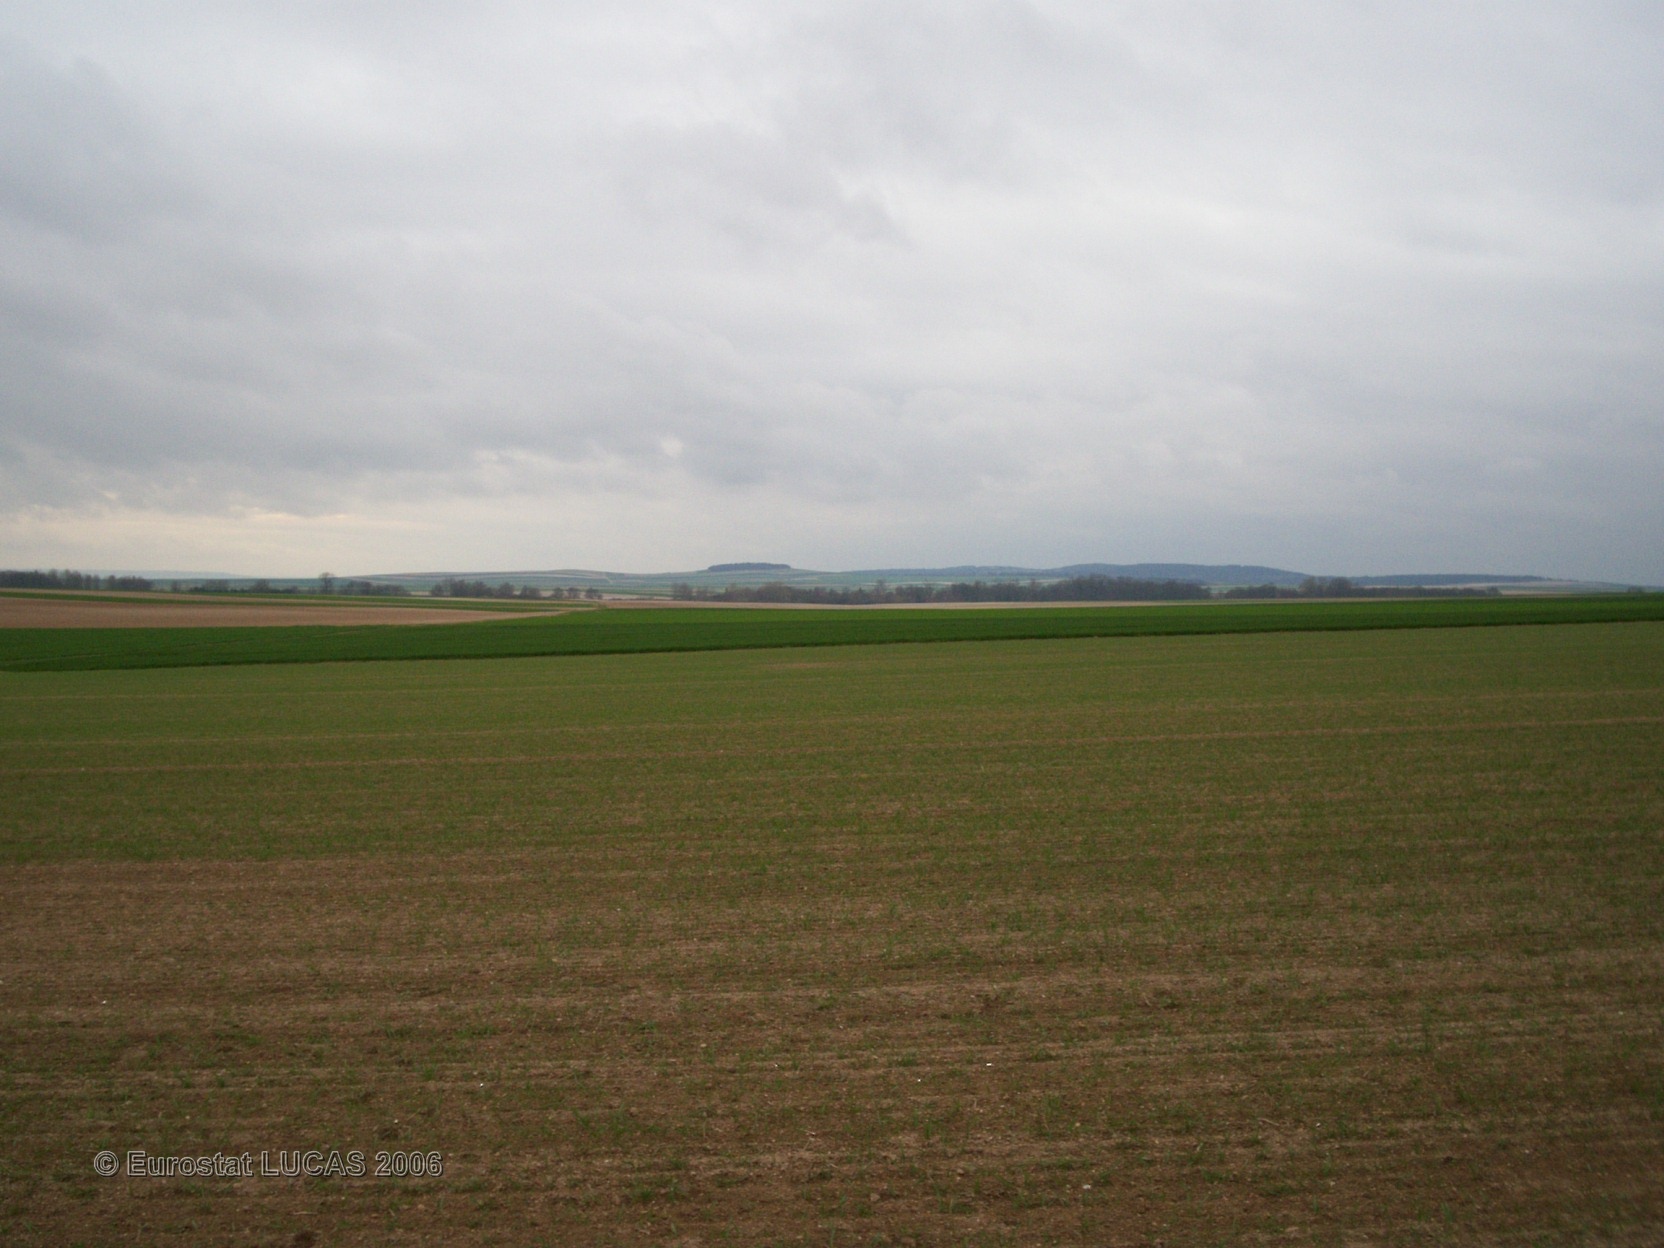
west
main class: Cropland
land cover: Barley
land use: Agriculture (excluding fallow land and kitchen gardens)
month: April
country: FR
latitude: 49.2191
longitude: 4.4359
